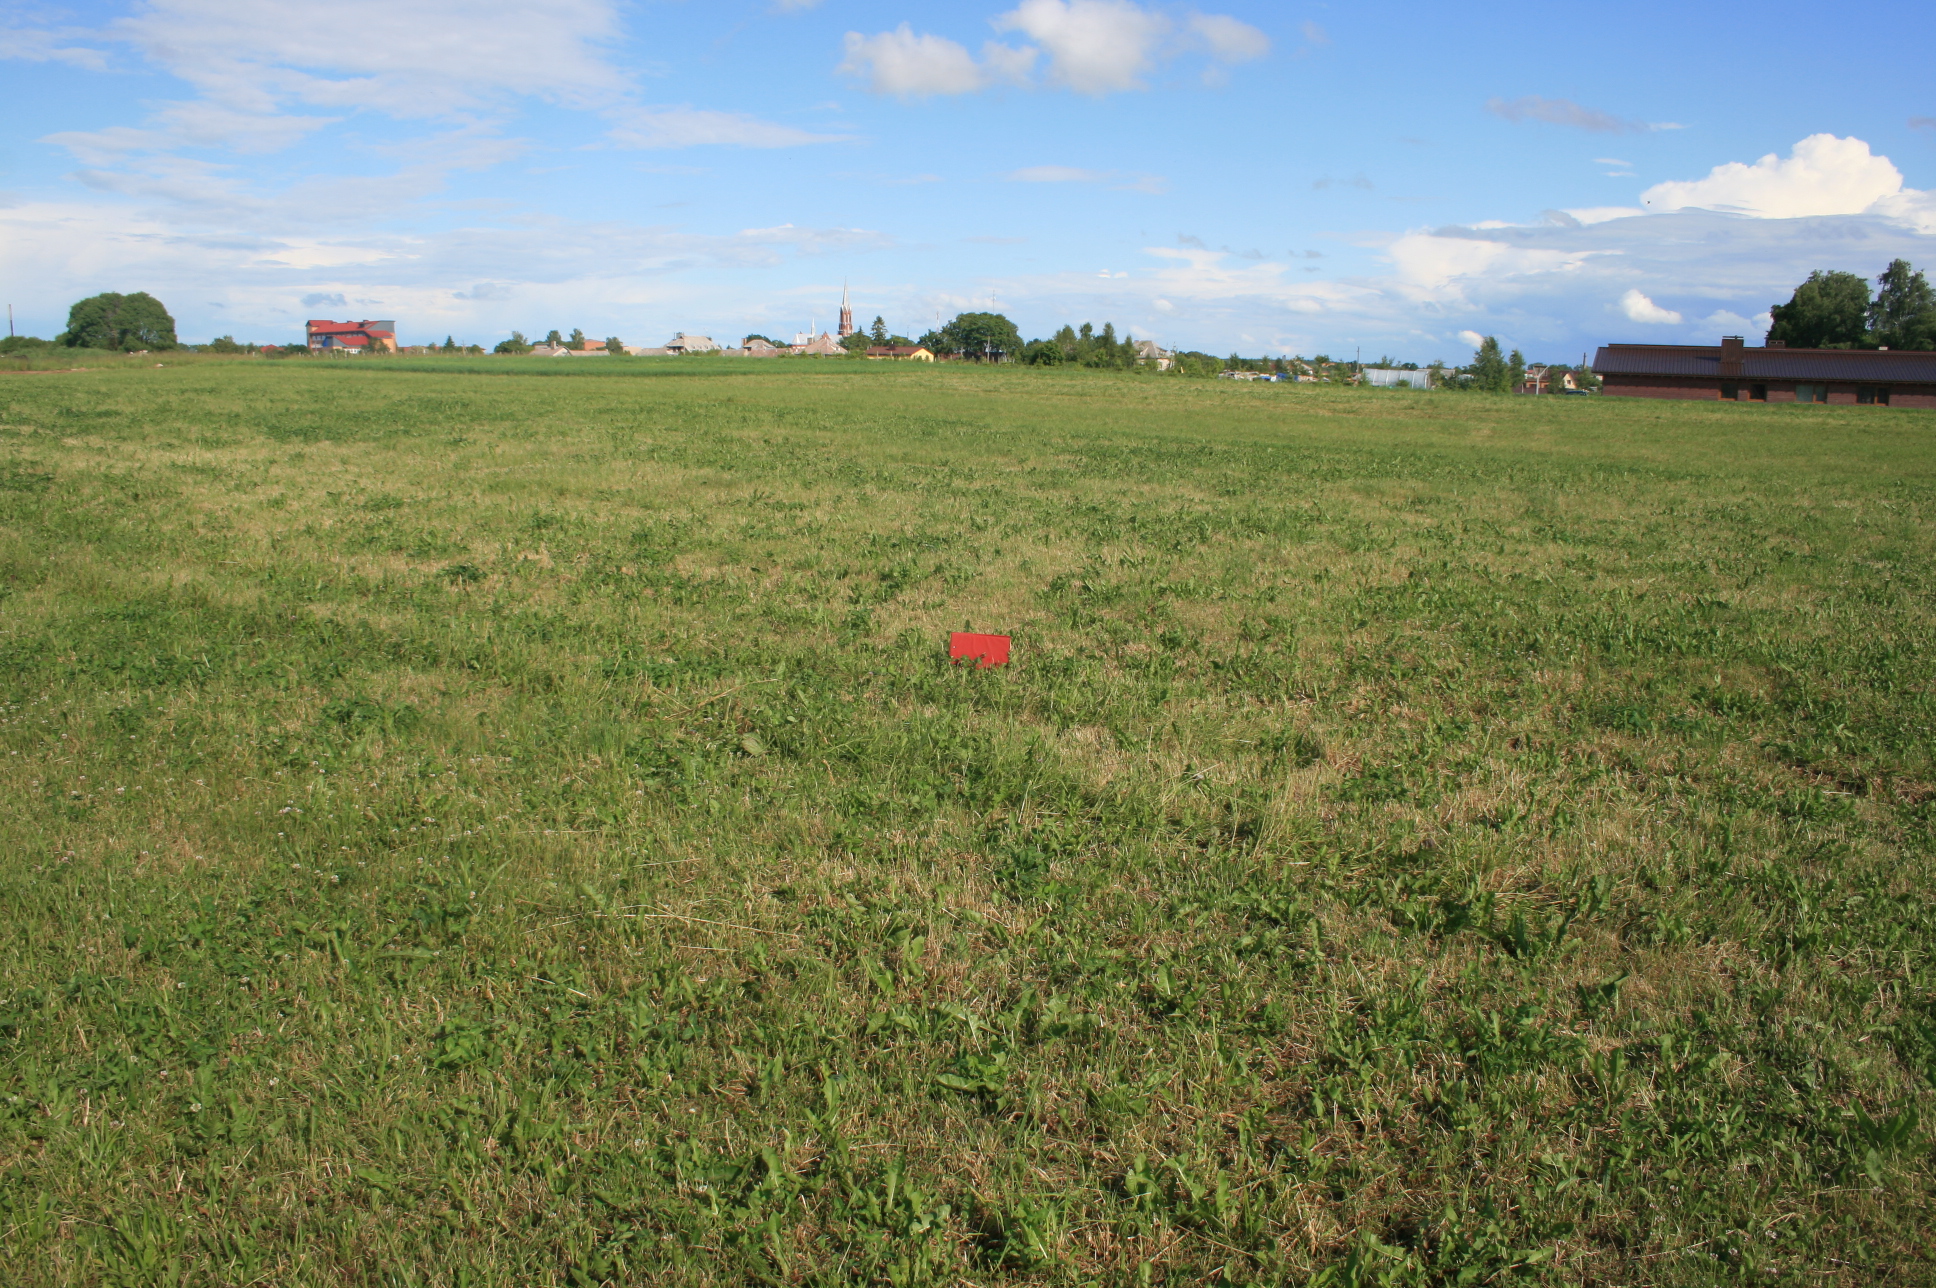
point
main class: Grassland
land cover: Grassland without tree/shrub cover
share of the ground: > 75 %
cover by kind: herbaceous plants 100 %
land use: Agriculture (excluding fallow land and kitchen gardens)
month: June
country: LT
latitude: 55.4971
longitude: 22.1652
